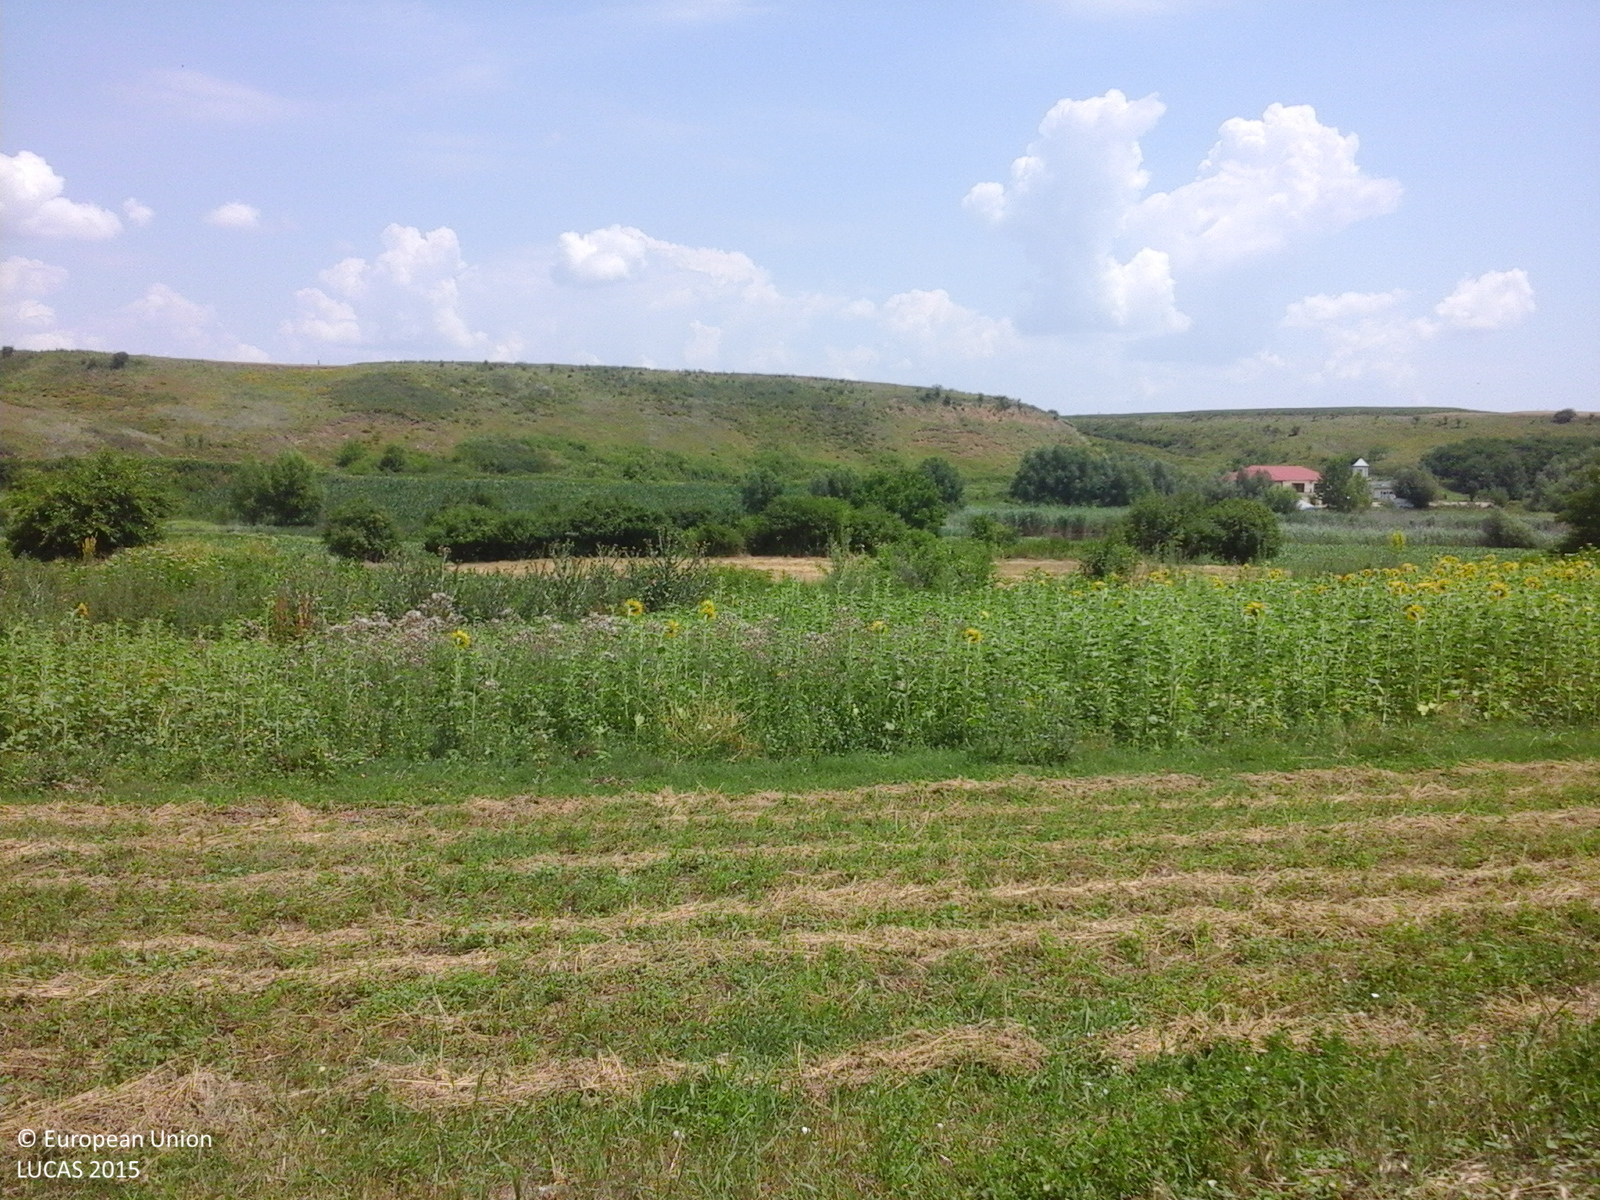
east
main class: Cropland
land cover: Lucerne
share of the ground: > 75 %
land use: Agriculture (excluding fallow land and kitchen gardens)
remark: Harvested field
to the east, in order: Lucerne; Sunflower; Spontaneously vegetated surfaces; Maize; Barley; Abandoned hedges; Barley; Maize; Inland marshes; Inland fresh water bodies; Inland marshes
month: July
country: RO
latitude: 44.1438
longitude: 26.4752
